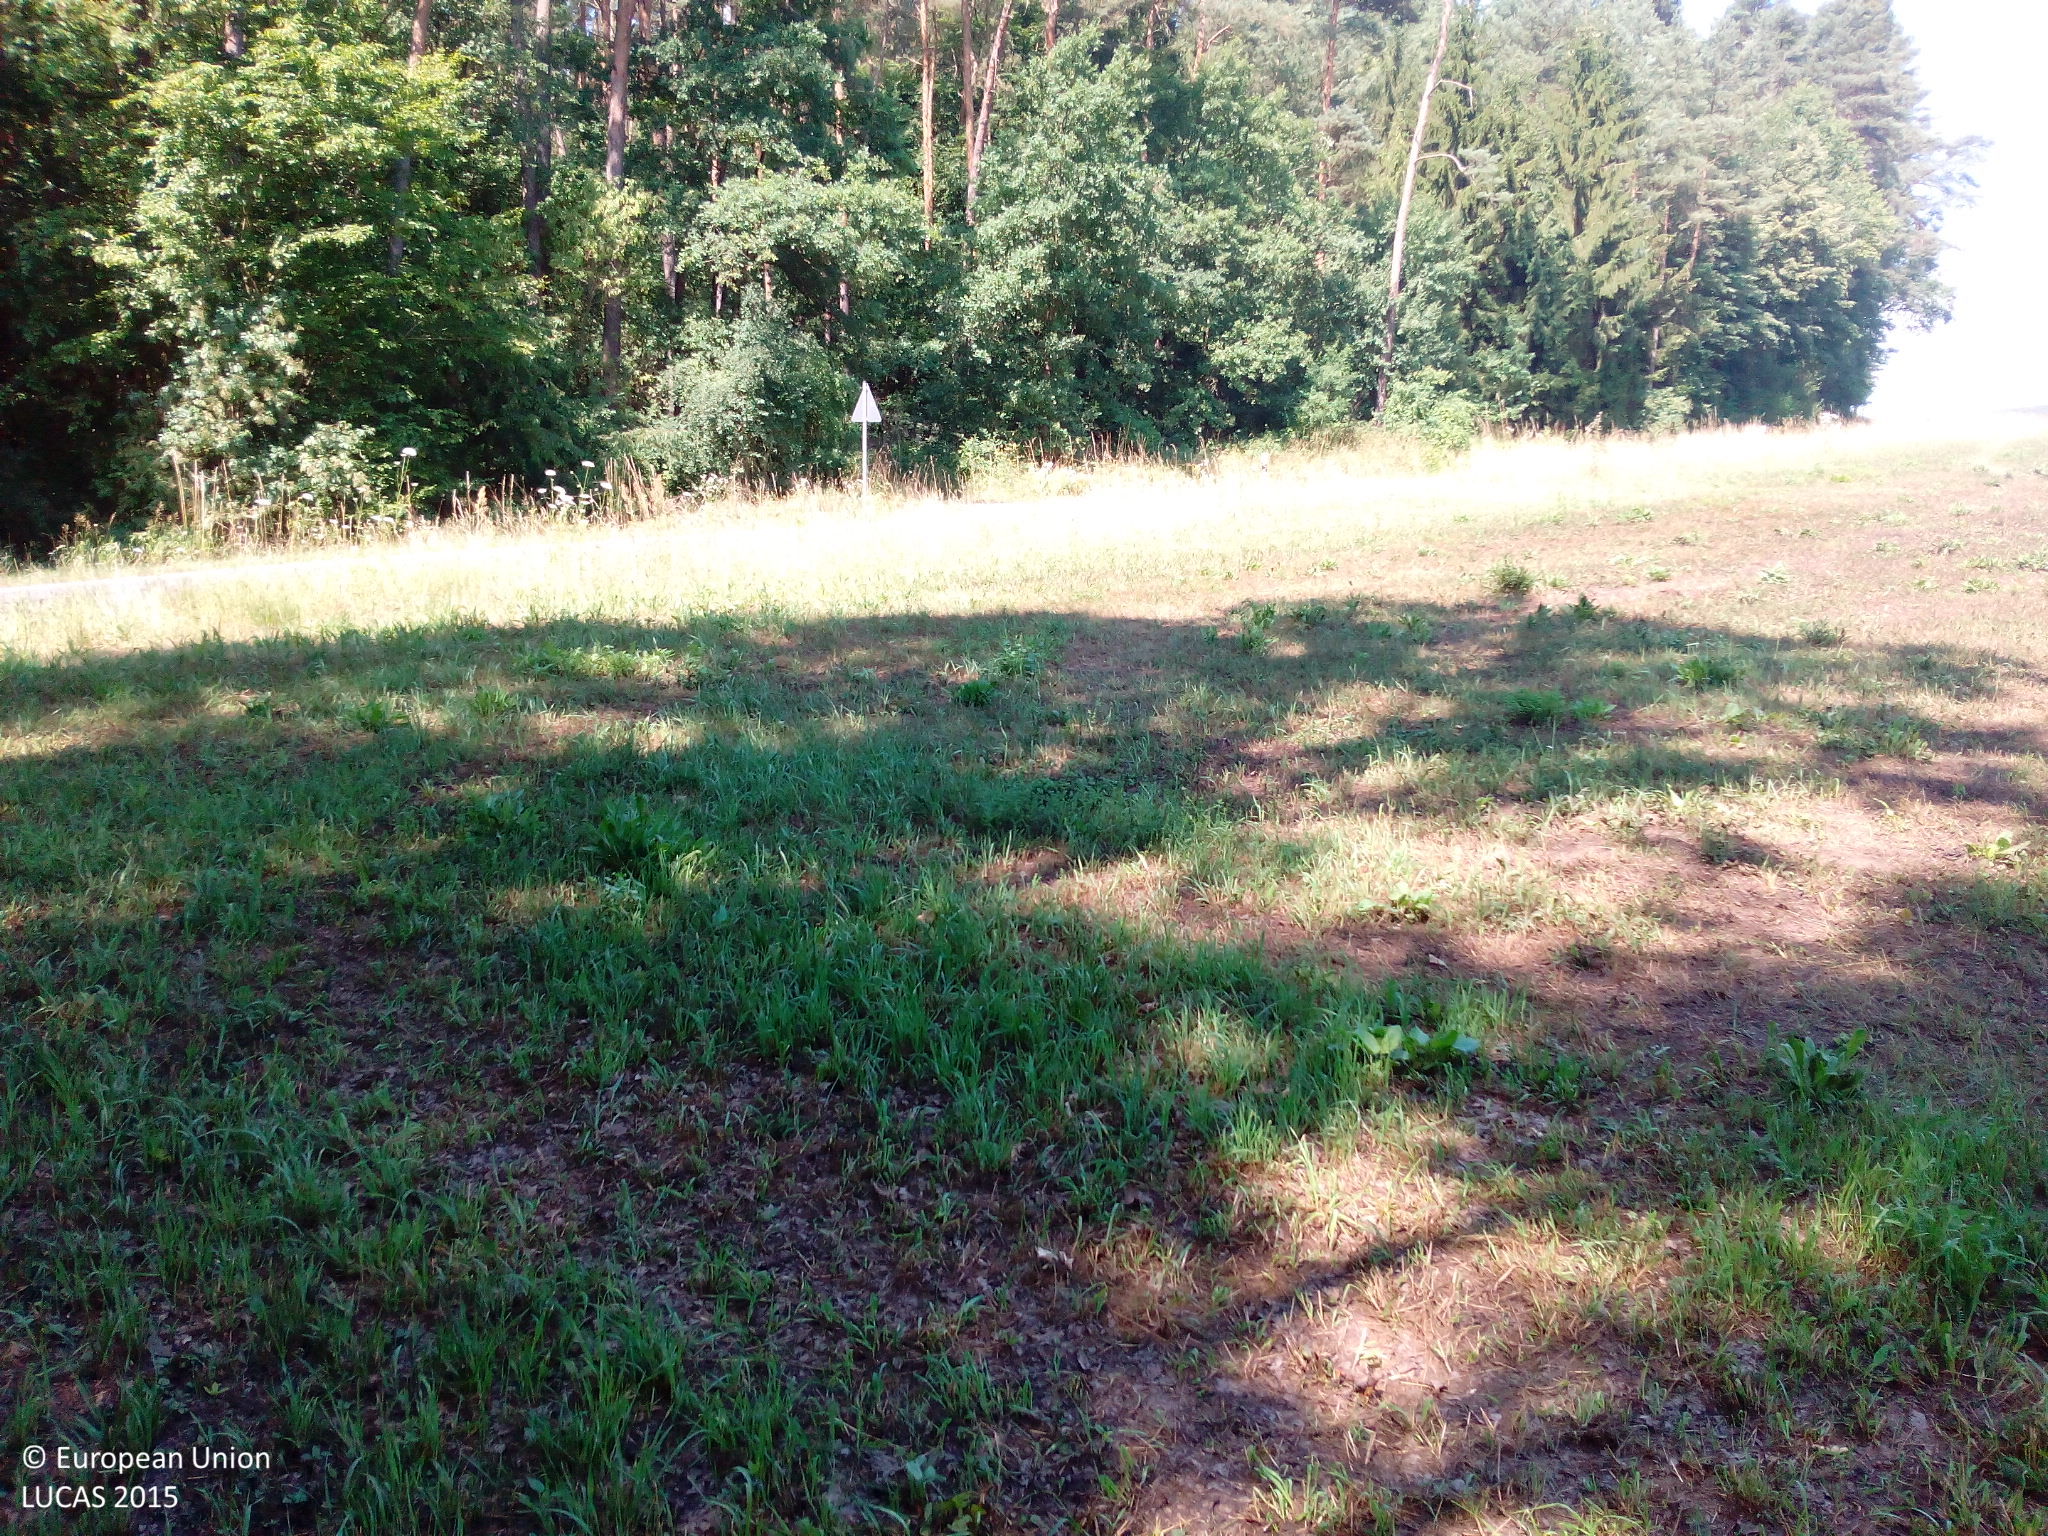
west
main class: Grassland
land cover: Grassland without tree/shrub cover
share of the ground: > 75 %
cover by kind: herbaceous plants 90 %, unconsolidated bare surface 10 %
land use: Agriculture (excluding fallow land and kitchen gardens)
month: July
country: DE
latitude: 49.7486
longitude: 10.9573
